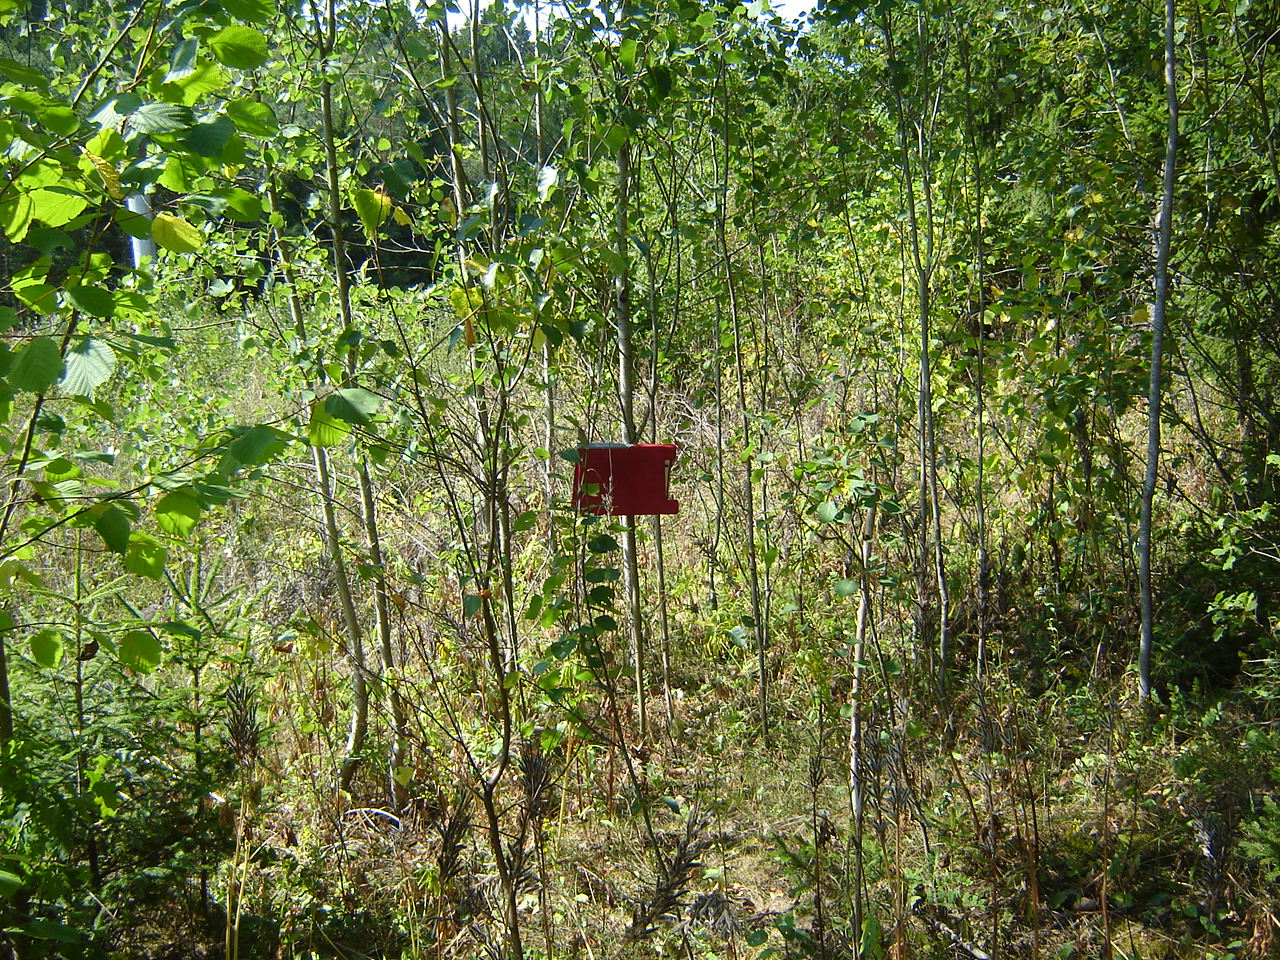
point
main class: Woodland
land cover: Broadleaved woodland
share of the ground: > 75 %
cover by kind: broadleaved forest trees 85 %, herbaceous plants 15 %
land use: Forestry
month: August
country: LT
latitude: 54.6820
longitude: 24.7979
